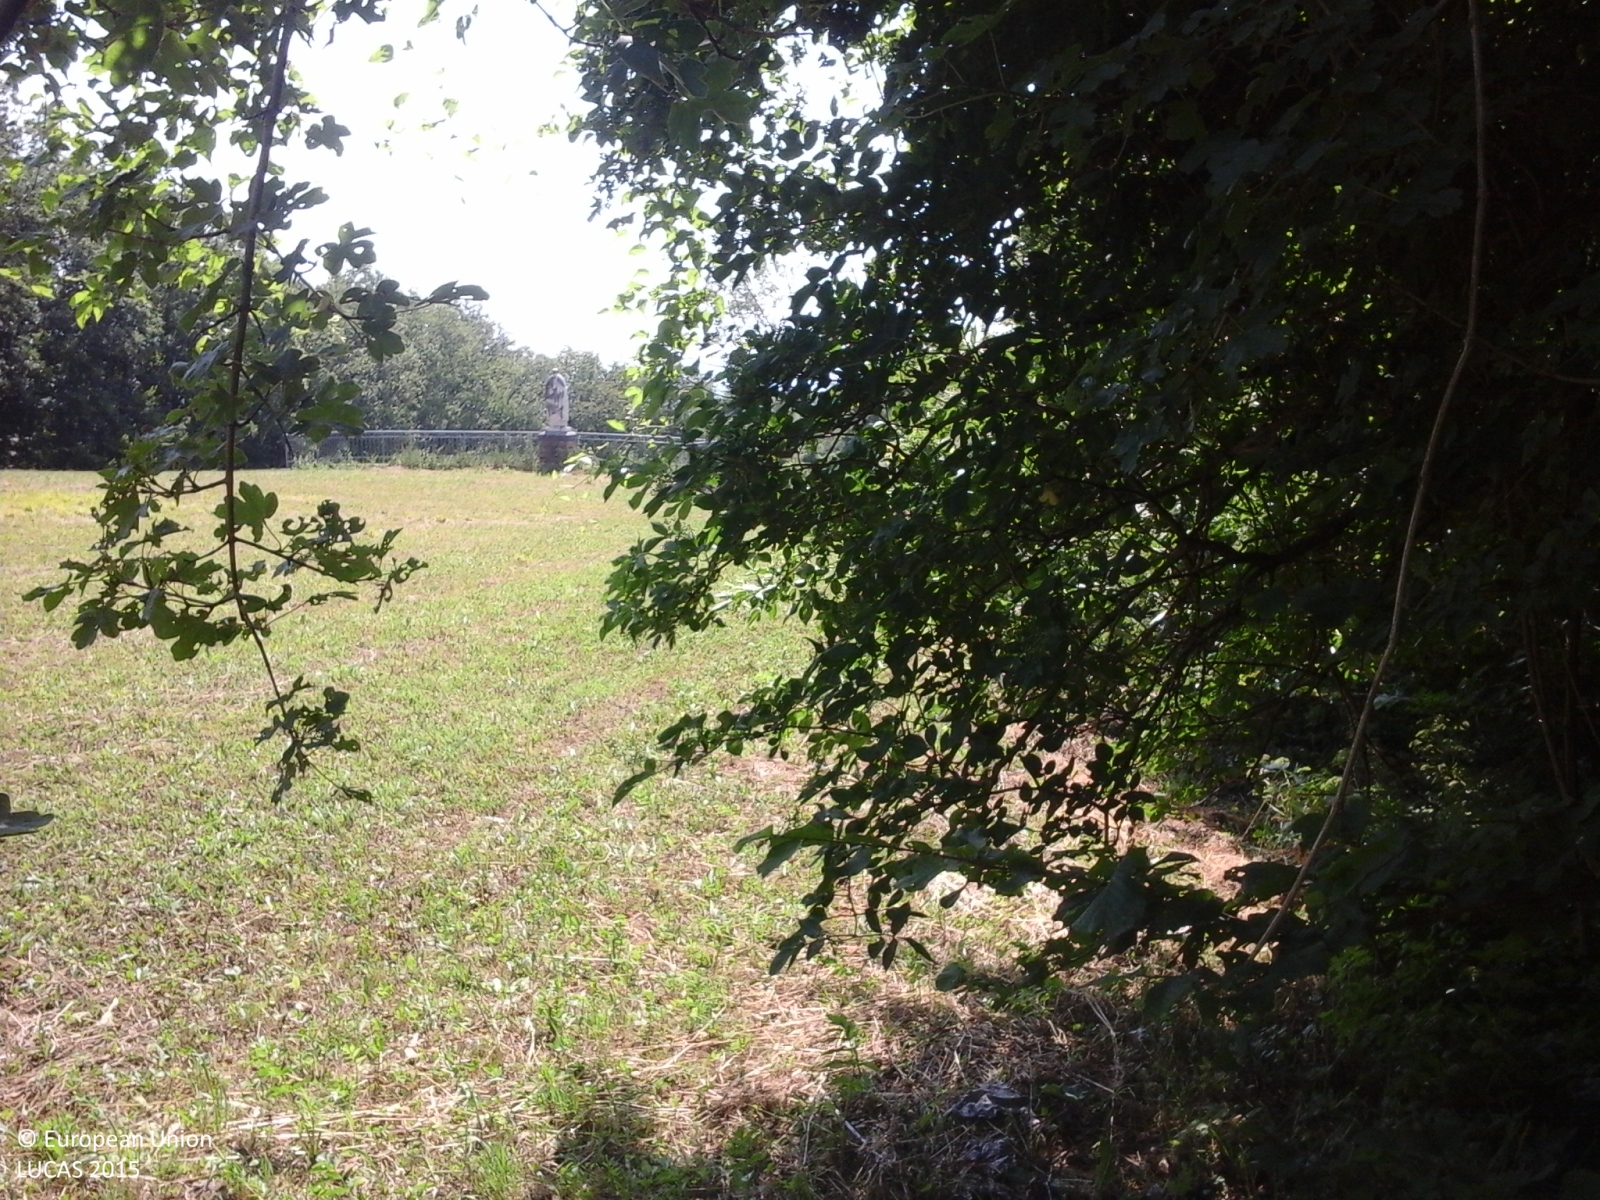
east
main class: Woodland
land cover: Broadleaved woodland
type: thermophilous deciduous forest
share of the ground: > 75 %
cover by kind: broadleaved forest trees 100 %
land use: Forestry
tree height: > 5 m
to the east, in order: Broadleaved woodland; Grassland without tree/shrub cover; Tracks; Grassland without tree/shrub cover; Broadleaved woodland; Tracks; Broadleaved woodland; Spontaneously vegetated surfaces; Broadleaved woodland; Ditches and canals; Broadleaved woodland
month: July
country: IT
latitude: 44.4585
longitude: 10.2132
